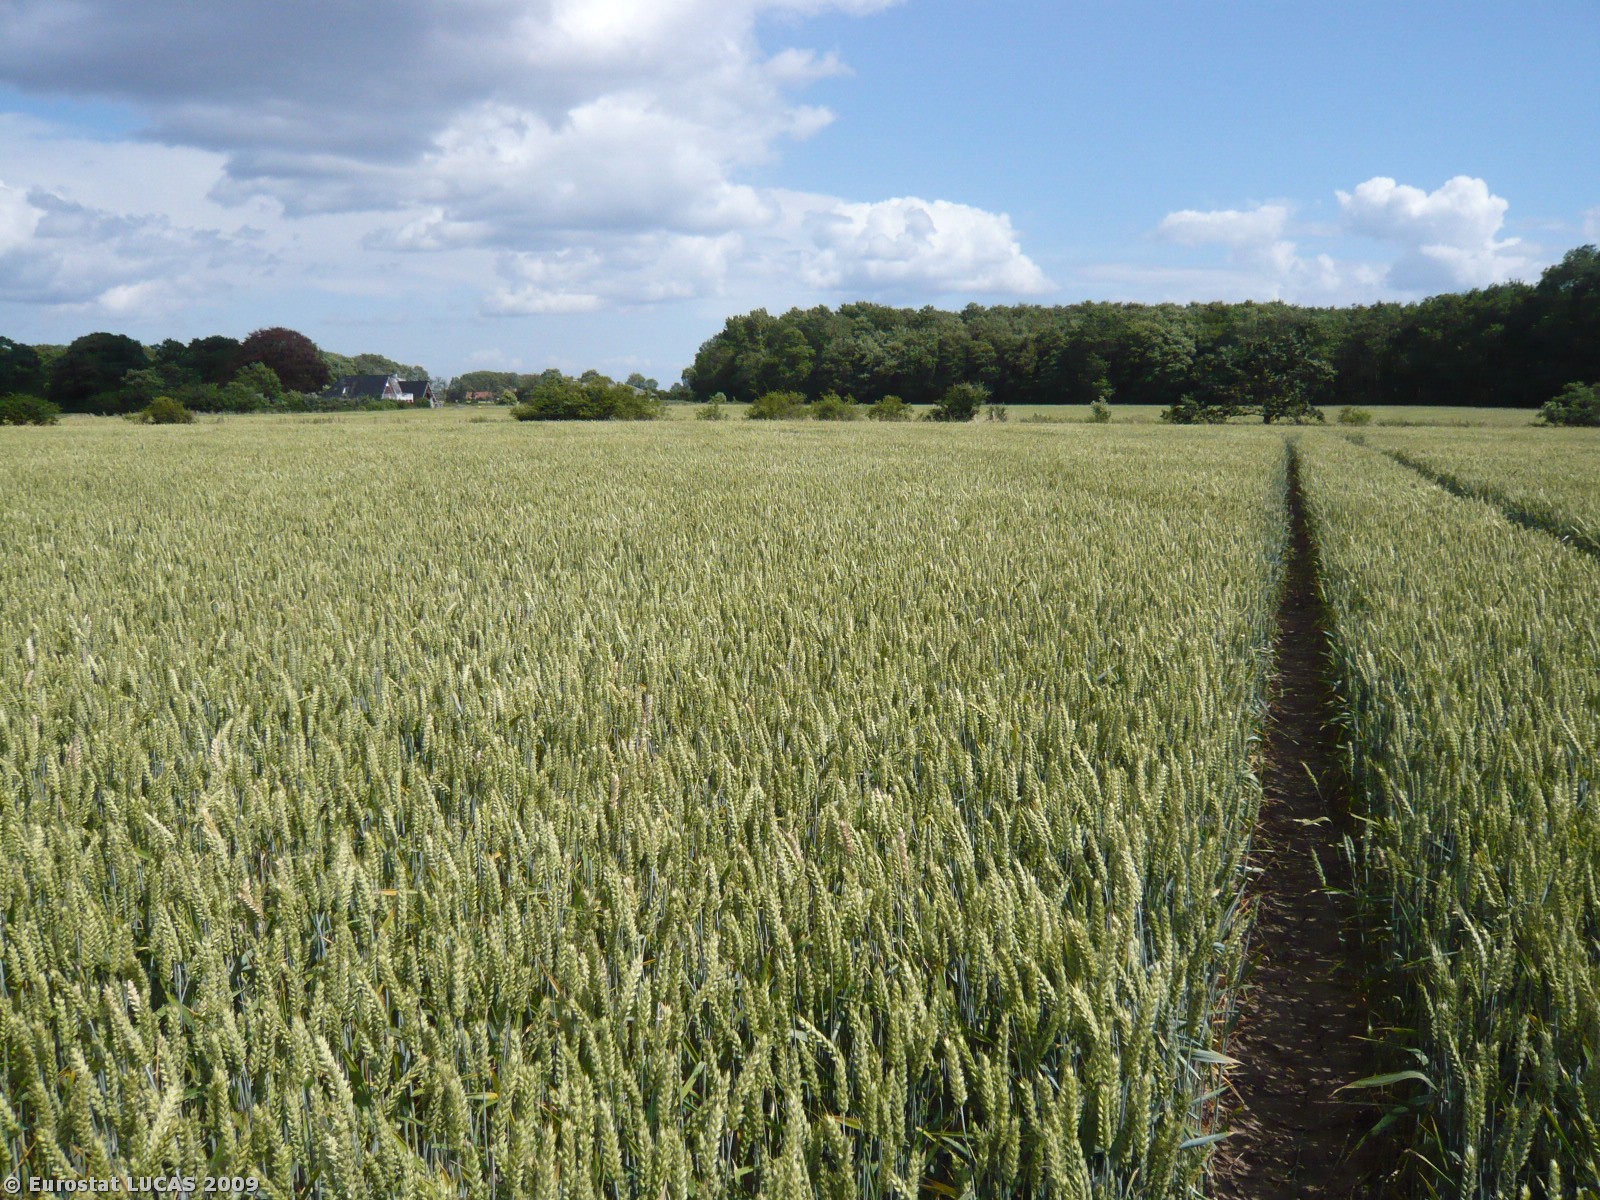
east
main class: Cropland
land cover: Common wheat
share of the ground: > 75 %
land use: Agriculture (excluding fallow land and kitchen gardens)
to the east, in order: Common wheat; Shrubland with sparse tree cover; Common wheat
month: July
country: DK
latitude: 55.4132
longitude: 10.6470
